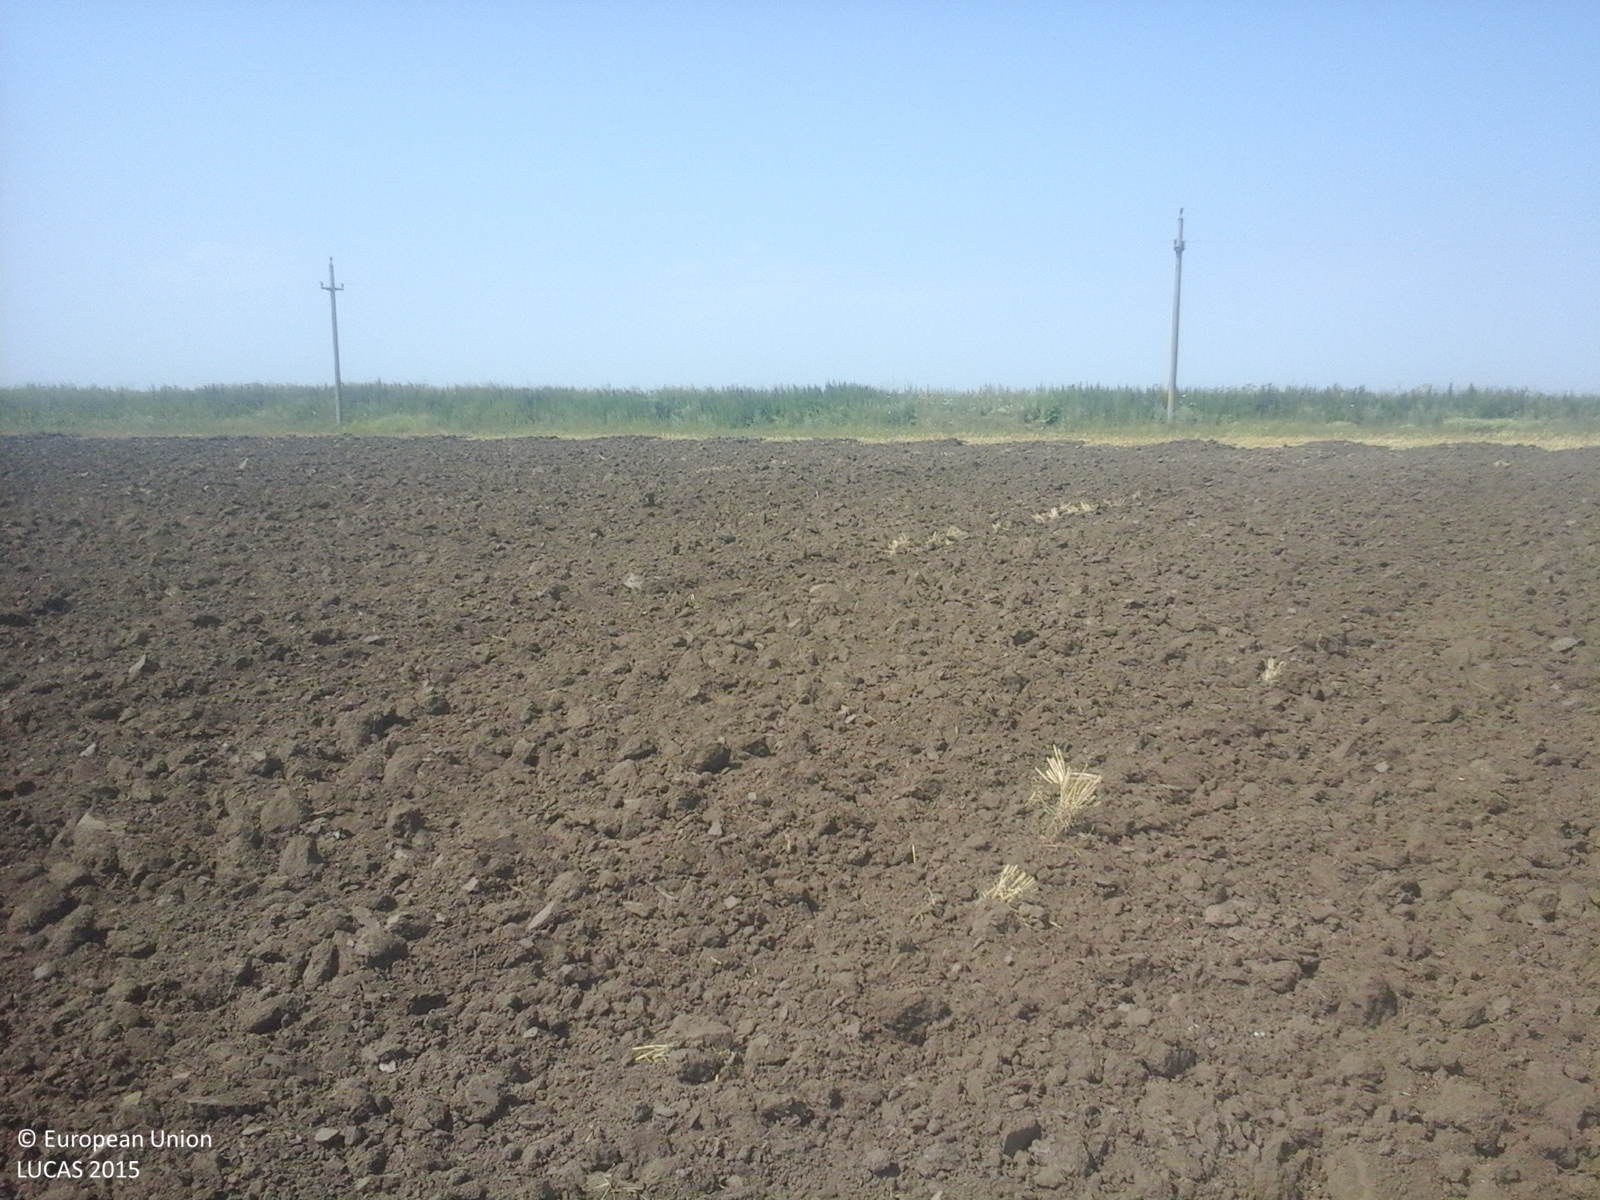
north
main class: Cropland
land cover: Common wheat
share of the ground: < 10 %
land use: Agriculture (excluding fallow land and kitchen gardens)
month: July
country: RO
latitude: 44.9848
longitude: 27.6155
